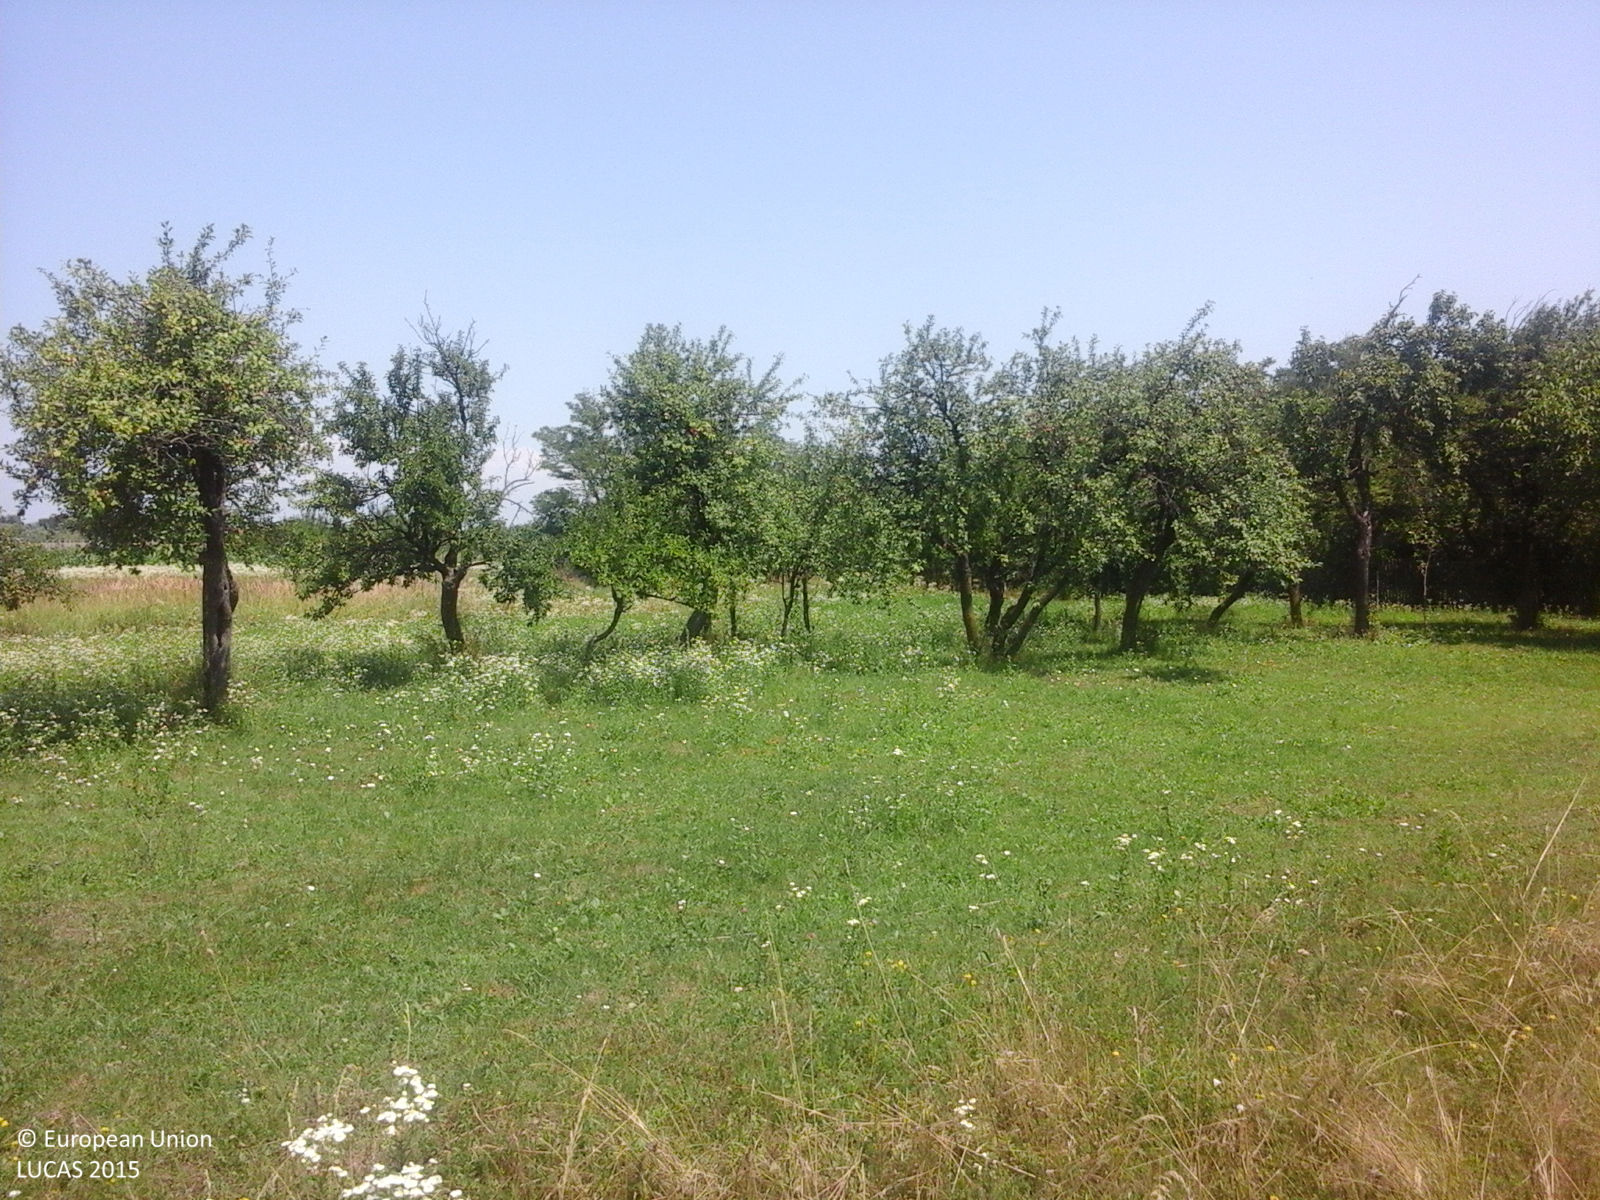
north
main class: Grassland
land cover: Spontaneously vegetated surfaces
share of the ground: > 75 %
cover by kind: herbaceous plants 100 %
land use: Agriculture (excluding fallow land and kitchen gardens)
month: July
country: RO
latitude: 44.7691
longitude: 24.9026
